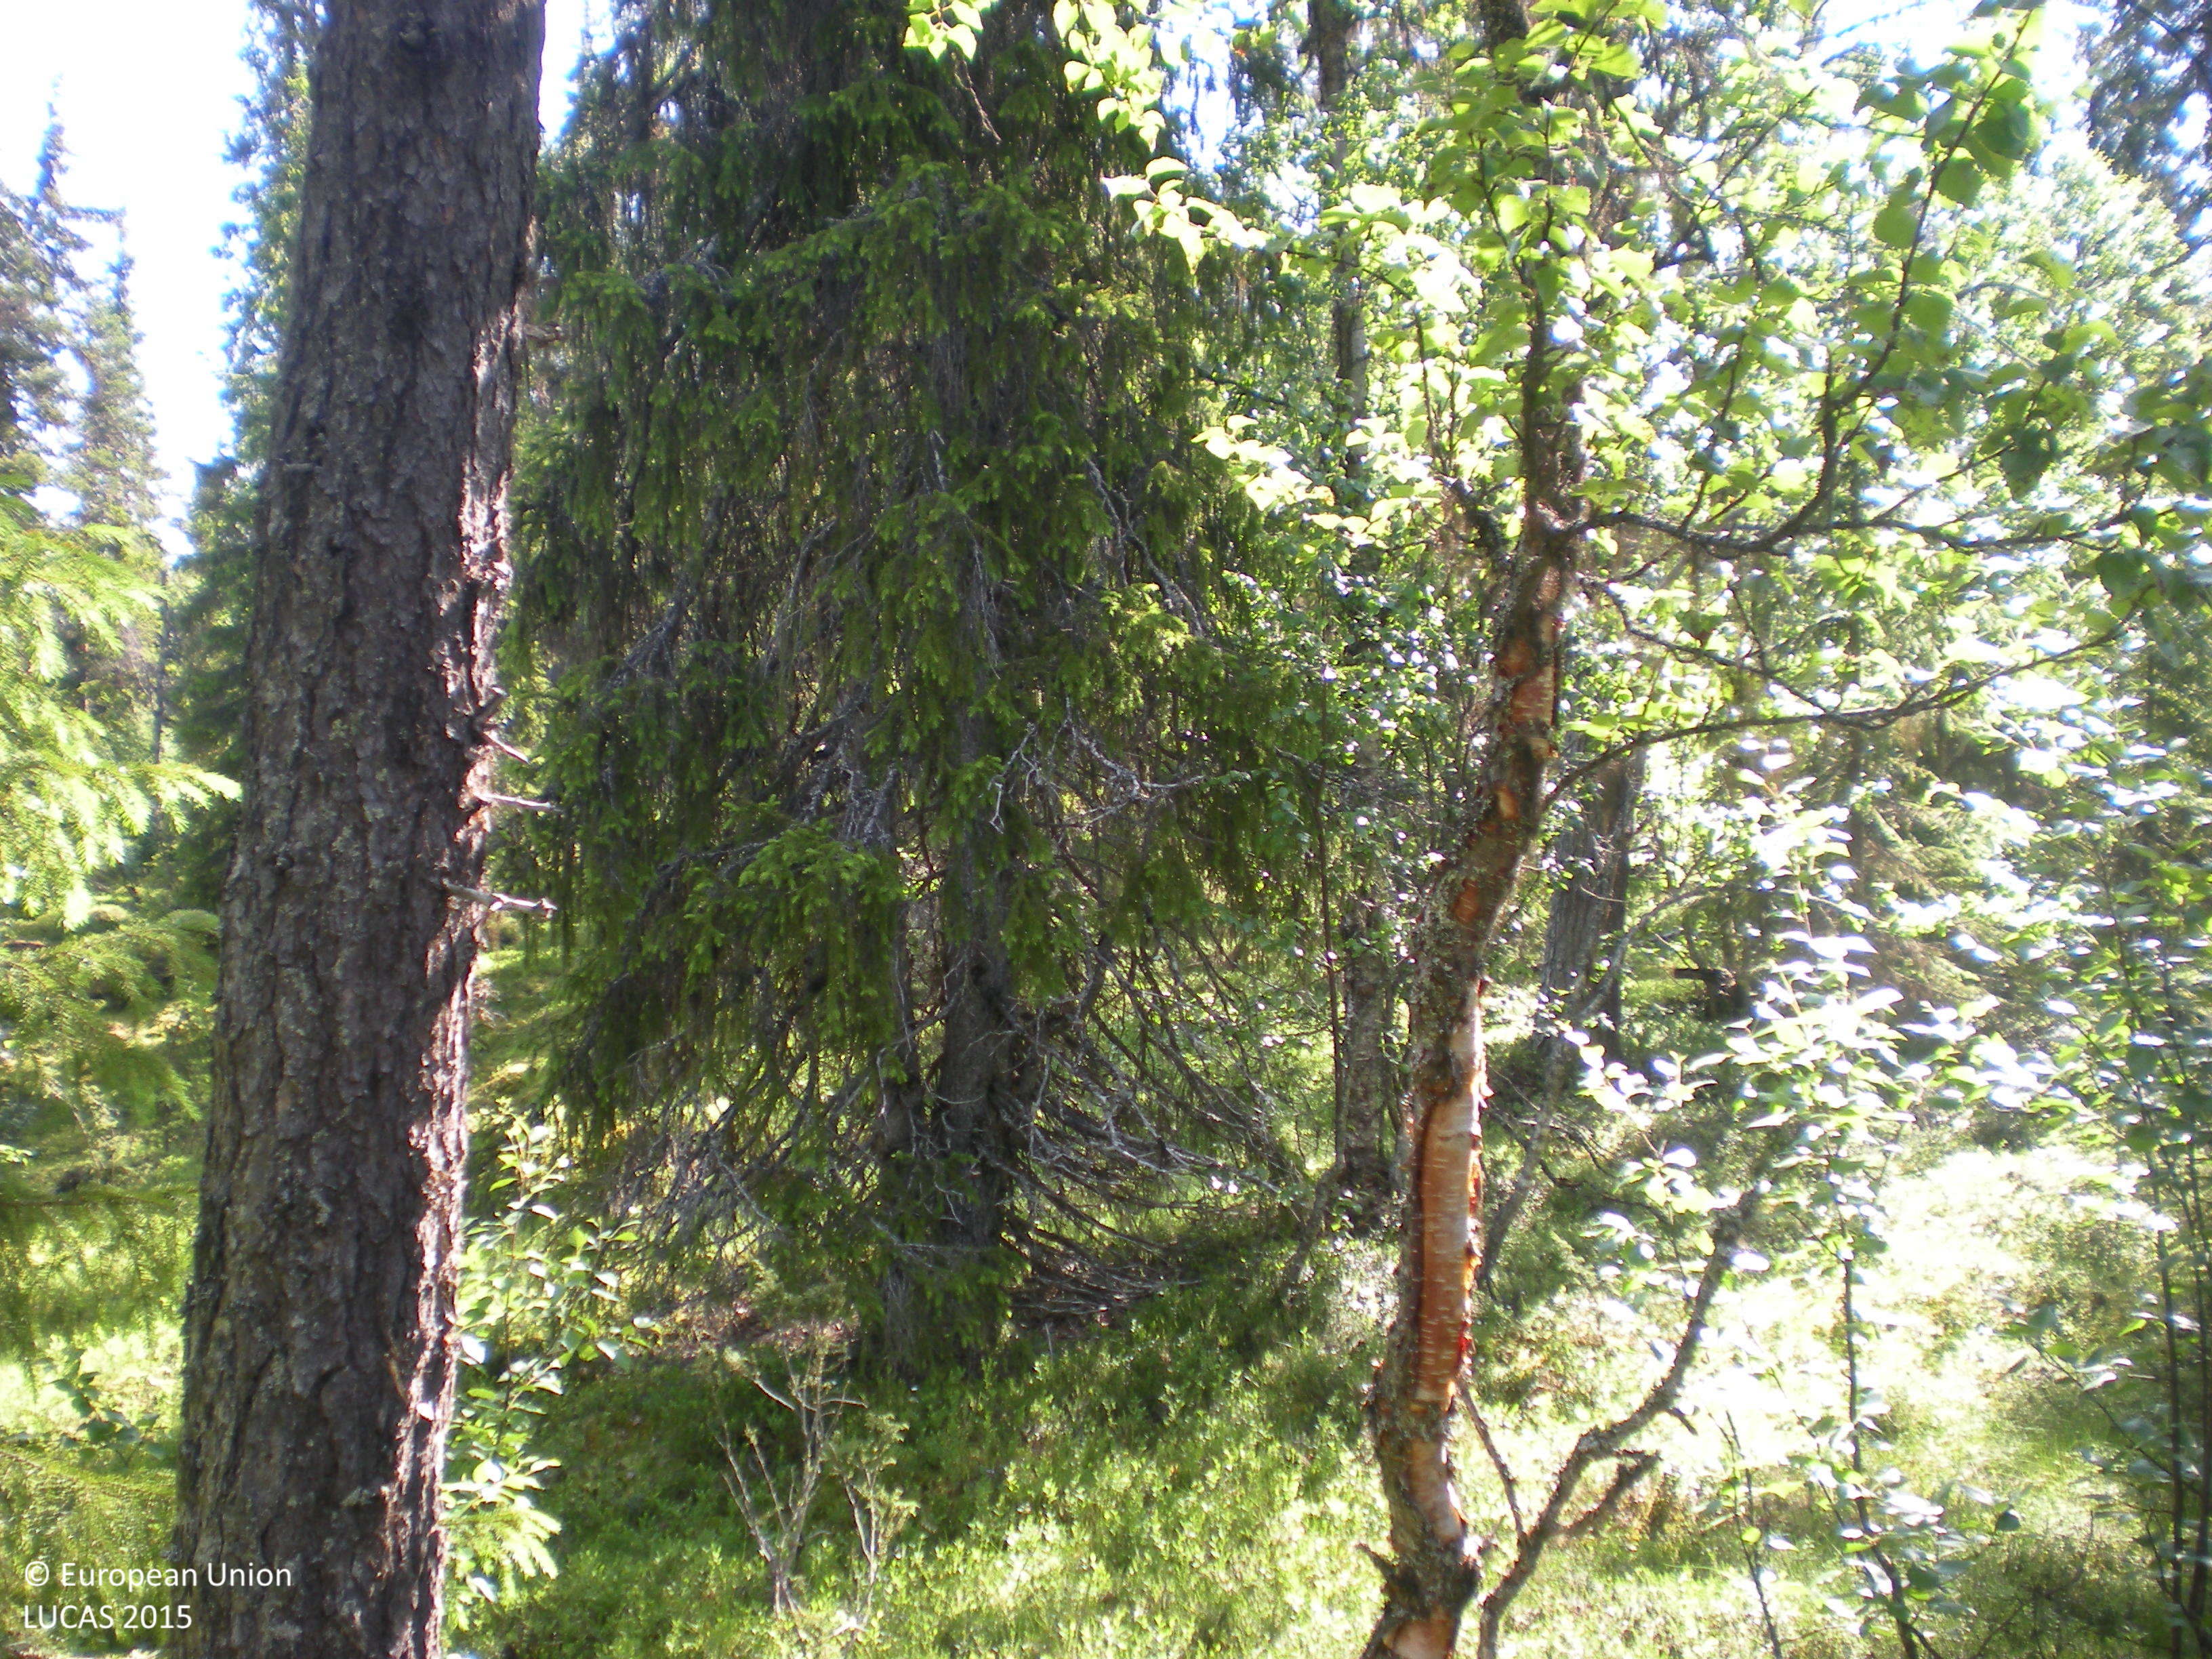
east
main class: Woodland
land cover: Spruce dominated mixed woodland
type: boreal forest
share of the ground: 50 - 75 %
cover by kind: coniferous forest trees 55 %, broadleaved forest trees 20 %, shrubs 10 %, lichens and mosses 10 %, herbaceous plants 5 %
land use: Semi-natural and natural areas not in use
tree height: > 5 m
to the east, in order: Spruce dominated mixed woodland
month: July
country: SE
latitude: 65.6466
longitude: 16.4154
